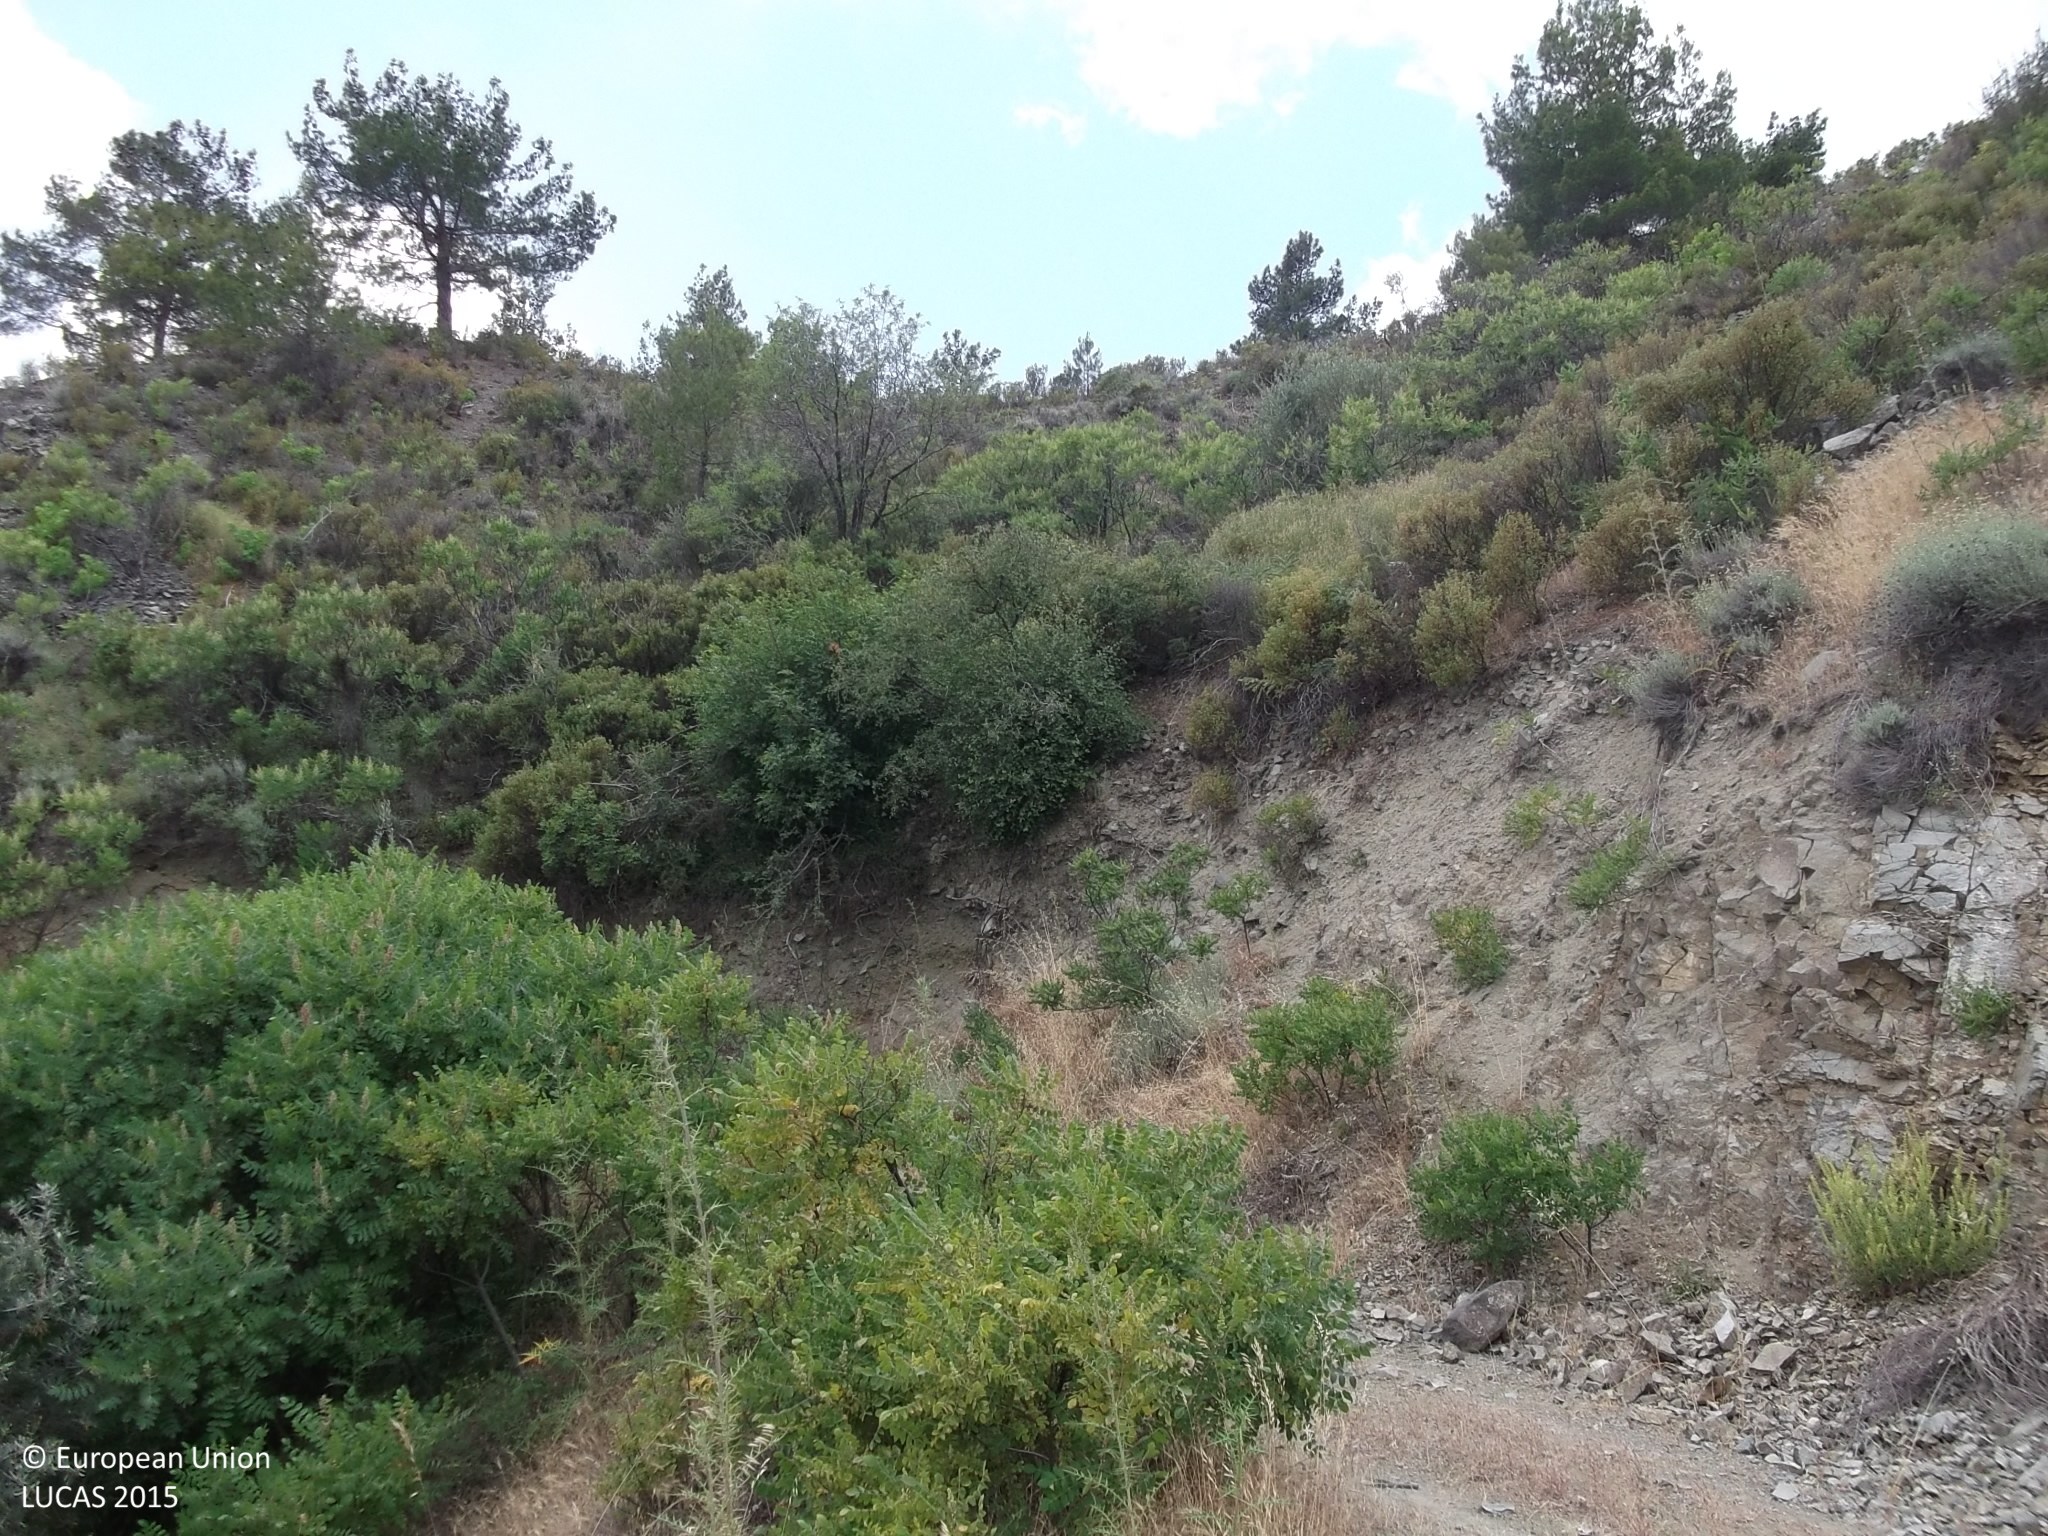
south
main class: Woodland
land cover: Pine dominated mixed woodland
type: coniferous forest of the mediterranean region
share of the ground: 25 - 50 %
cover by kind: coniferous forest trees 45 %, shrubs 25 %, broadleaved forest trees 15 %, consolidated bare surface 15 %
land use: Forestry
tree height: > 5 m
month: June
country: CY
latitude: 34.8798
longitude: 32.9578
